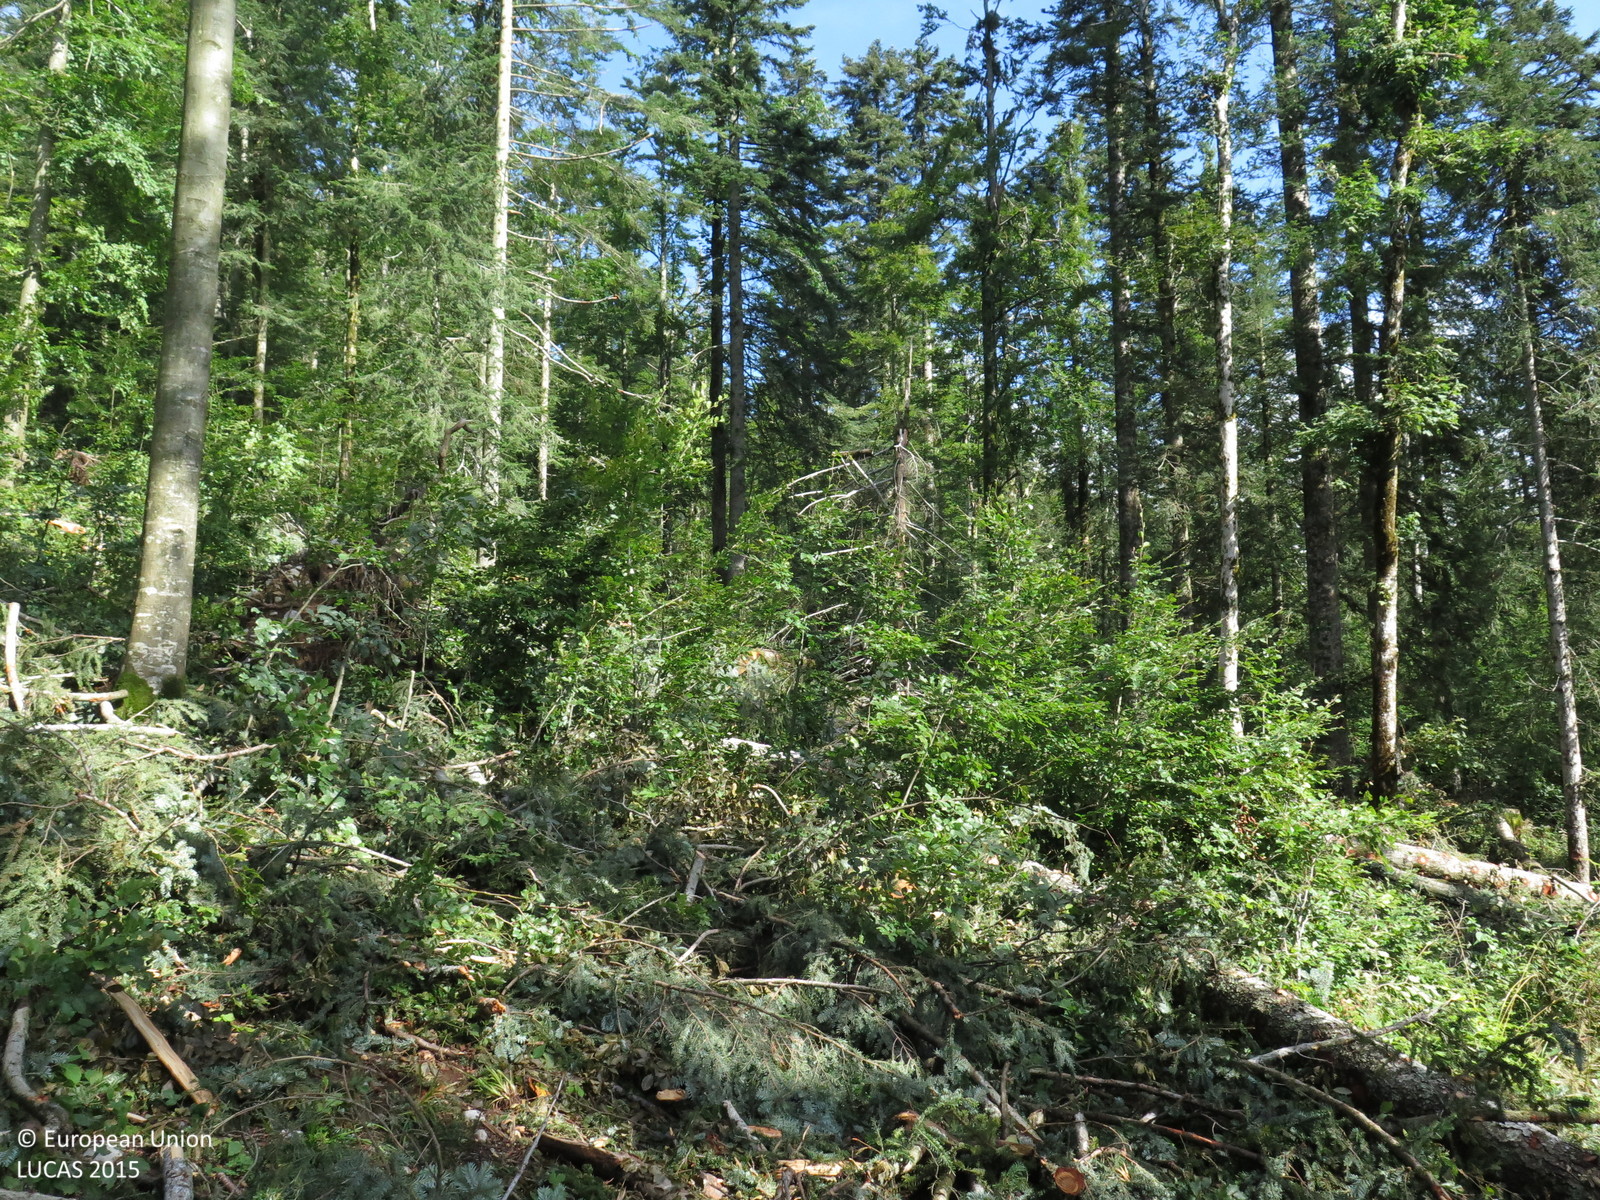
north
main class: Woodland
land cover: Other mixed woodland
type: mountainous beech forest
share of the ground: > 75 %
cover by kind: broadleaved forest trees 75 %, coniferous forest trees 25 %
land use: Forestry
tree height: > 5 m
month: September
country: HR
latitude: 45.4758
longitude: 14.6133
